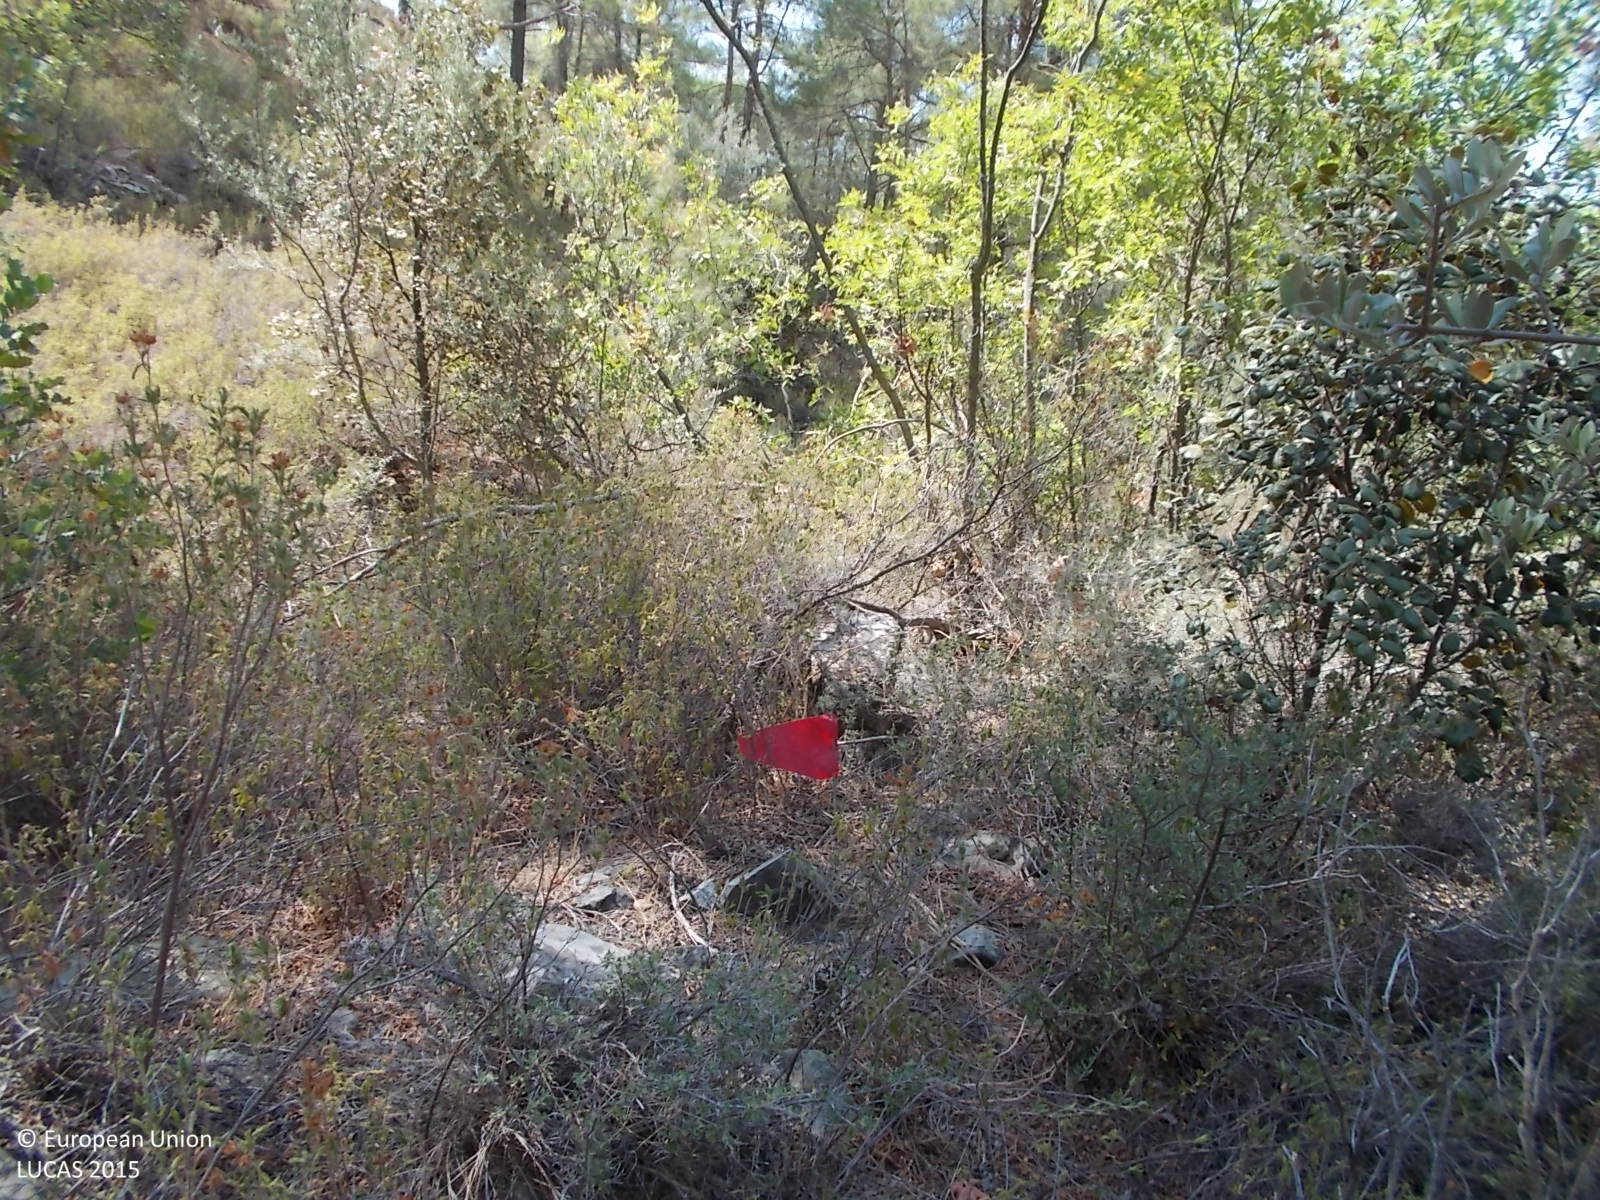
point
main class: Woodland
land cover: Pine dominated mixed woodland
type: coniferous forest of the mediterranean region
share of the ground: 50 - 75 %
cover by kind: coniferous forest trees 45 %, shrubs 25 %, broadleaved forest trees 15 %, unconsolidated bare surface 15 %
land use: Semi-natural and natural areas not in use
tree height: > 5 m
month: September
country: CY
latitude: 34.8648
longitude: 33.0896
